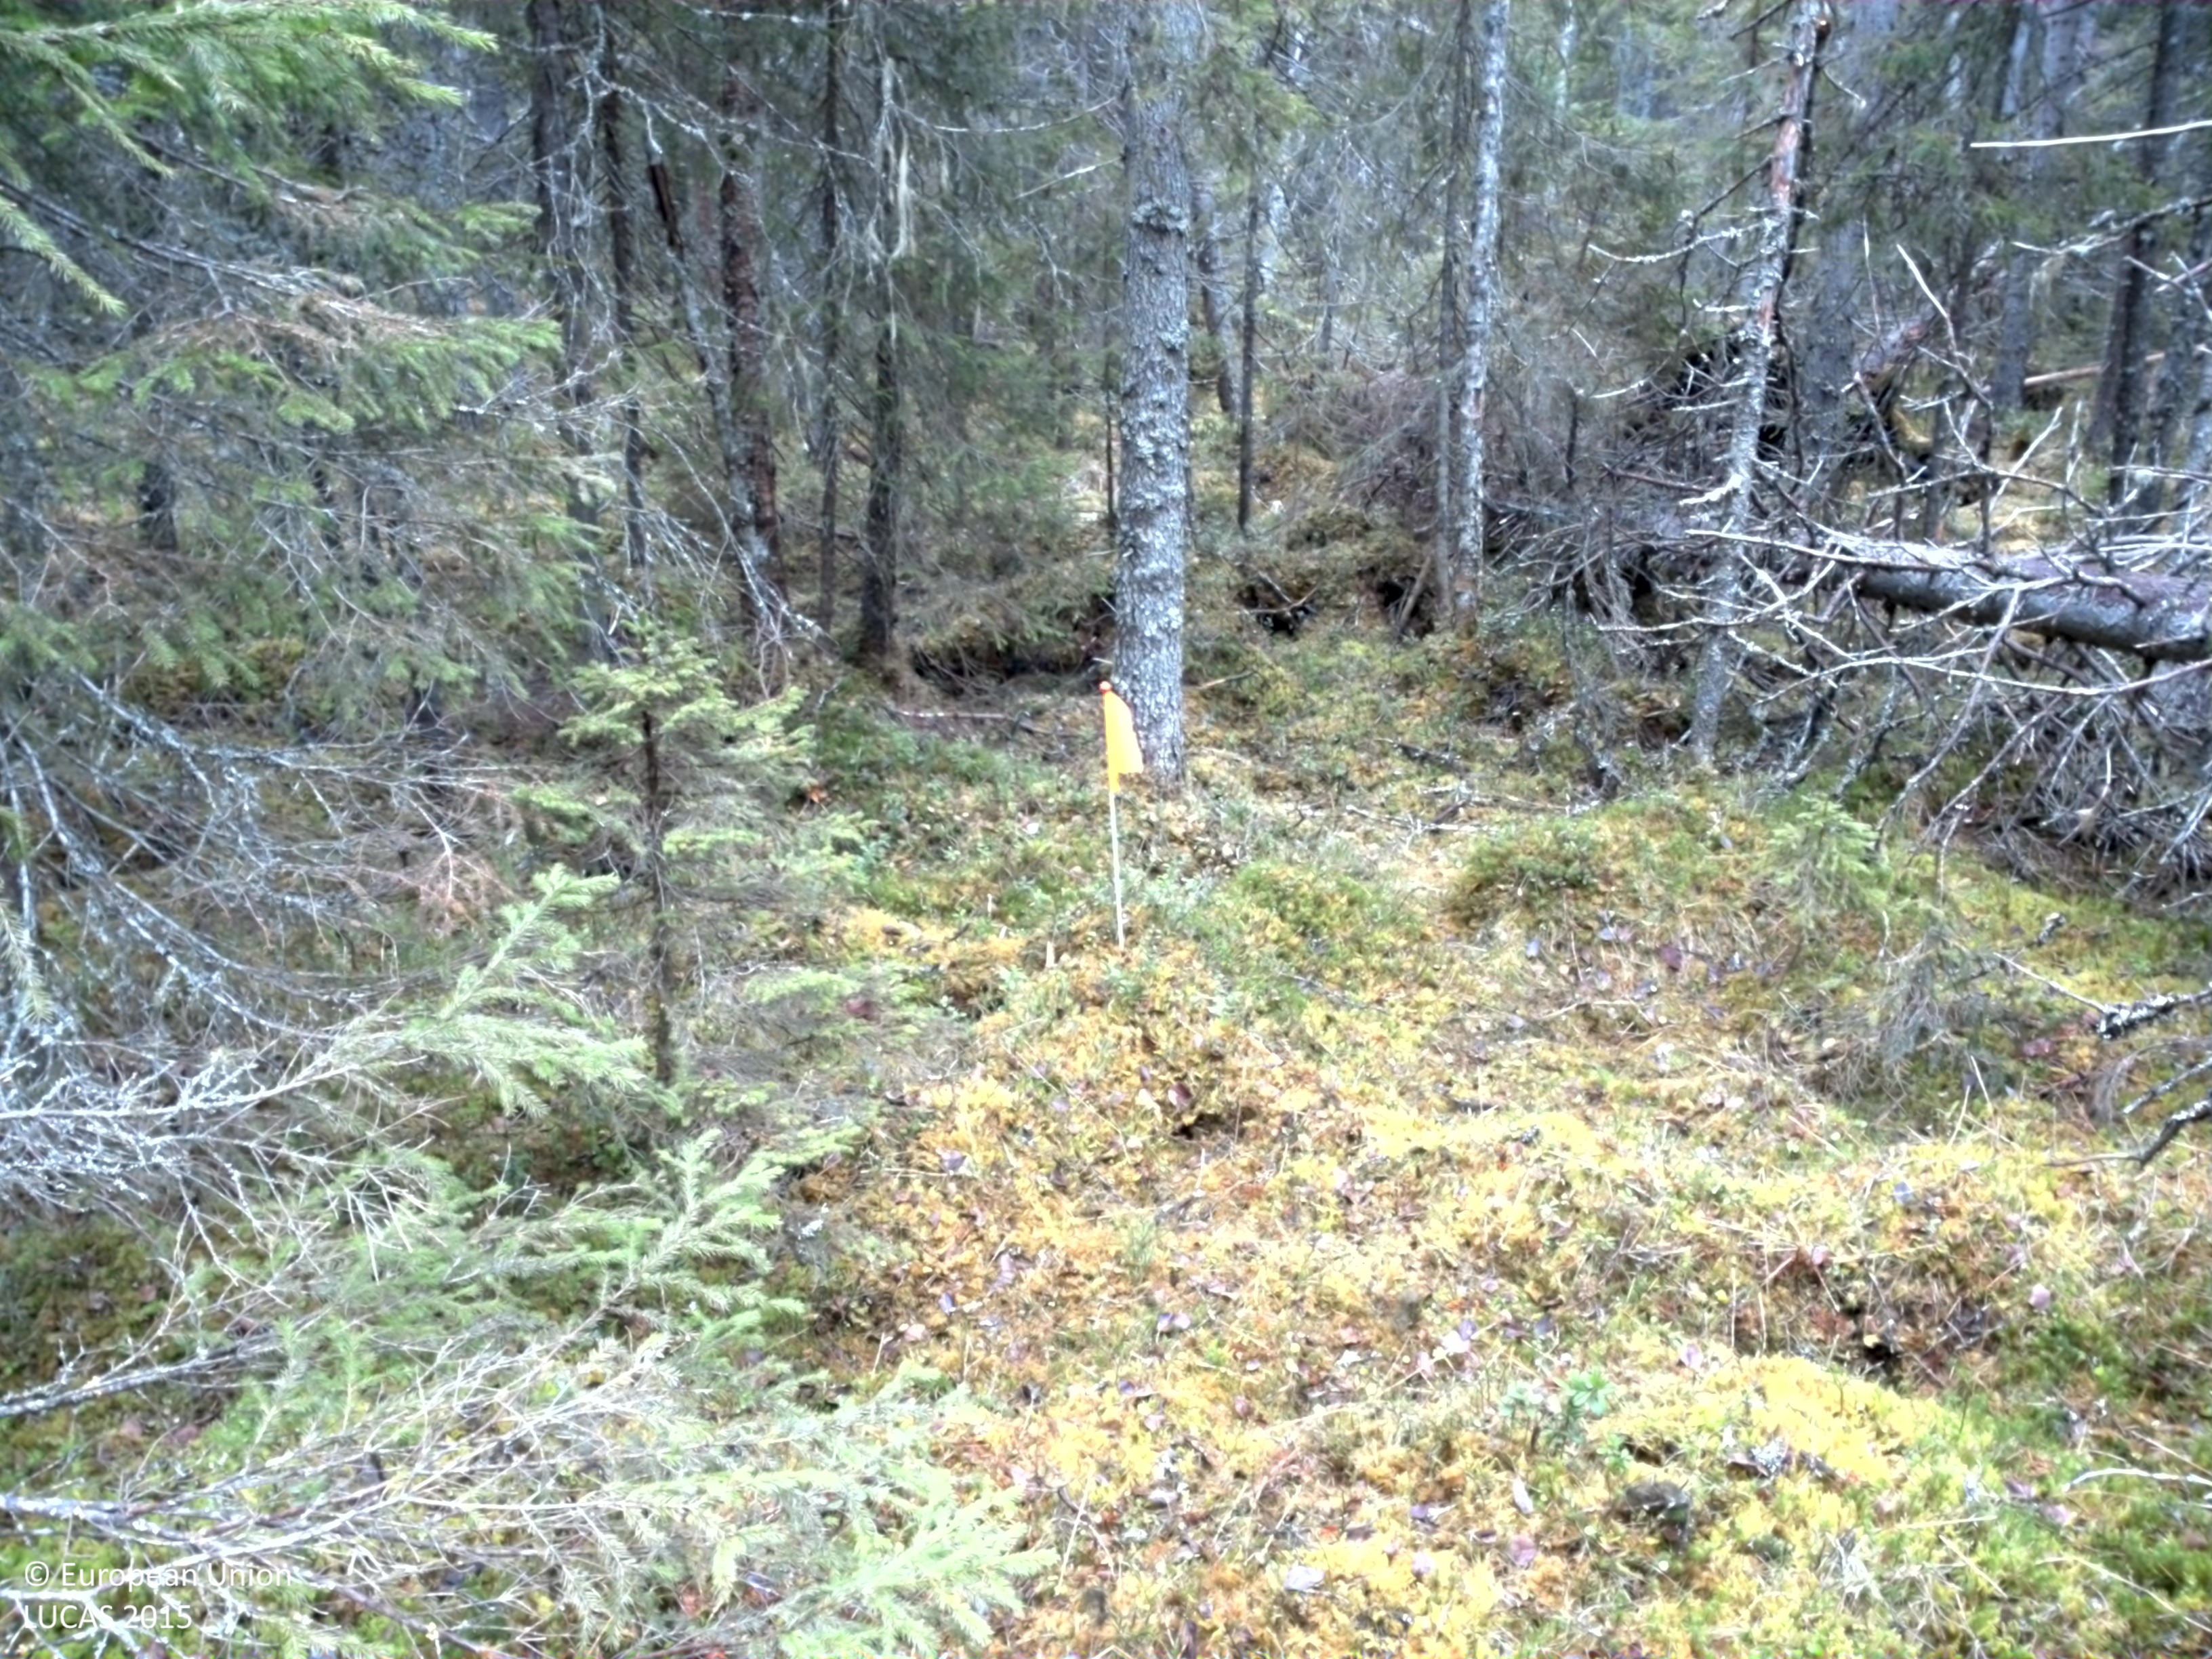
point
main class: Woodland
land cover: Spruce dominated coniferous woodland
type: boreal forest
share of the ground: > 75 %
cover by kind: coniferous forest trees 80 %, lichens and mosses 15 %, broadleaved forest trees 5 %
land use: Forestry
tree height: > 5 m
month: May
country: SE
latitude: 63.3598
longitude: 13.7591
